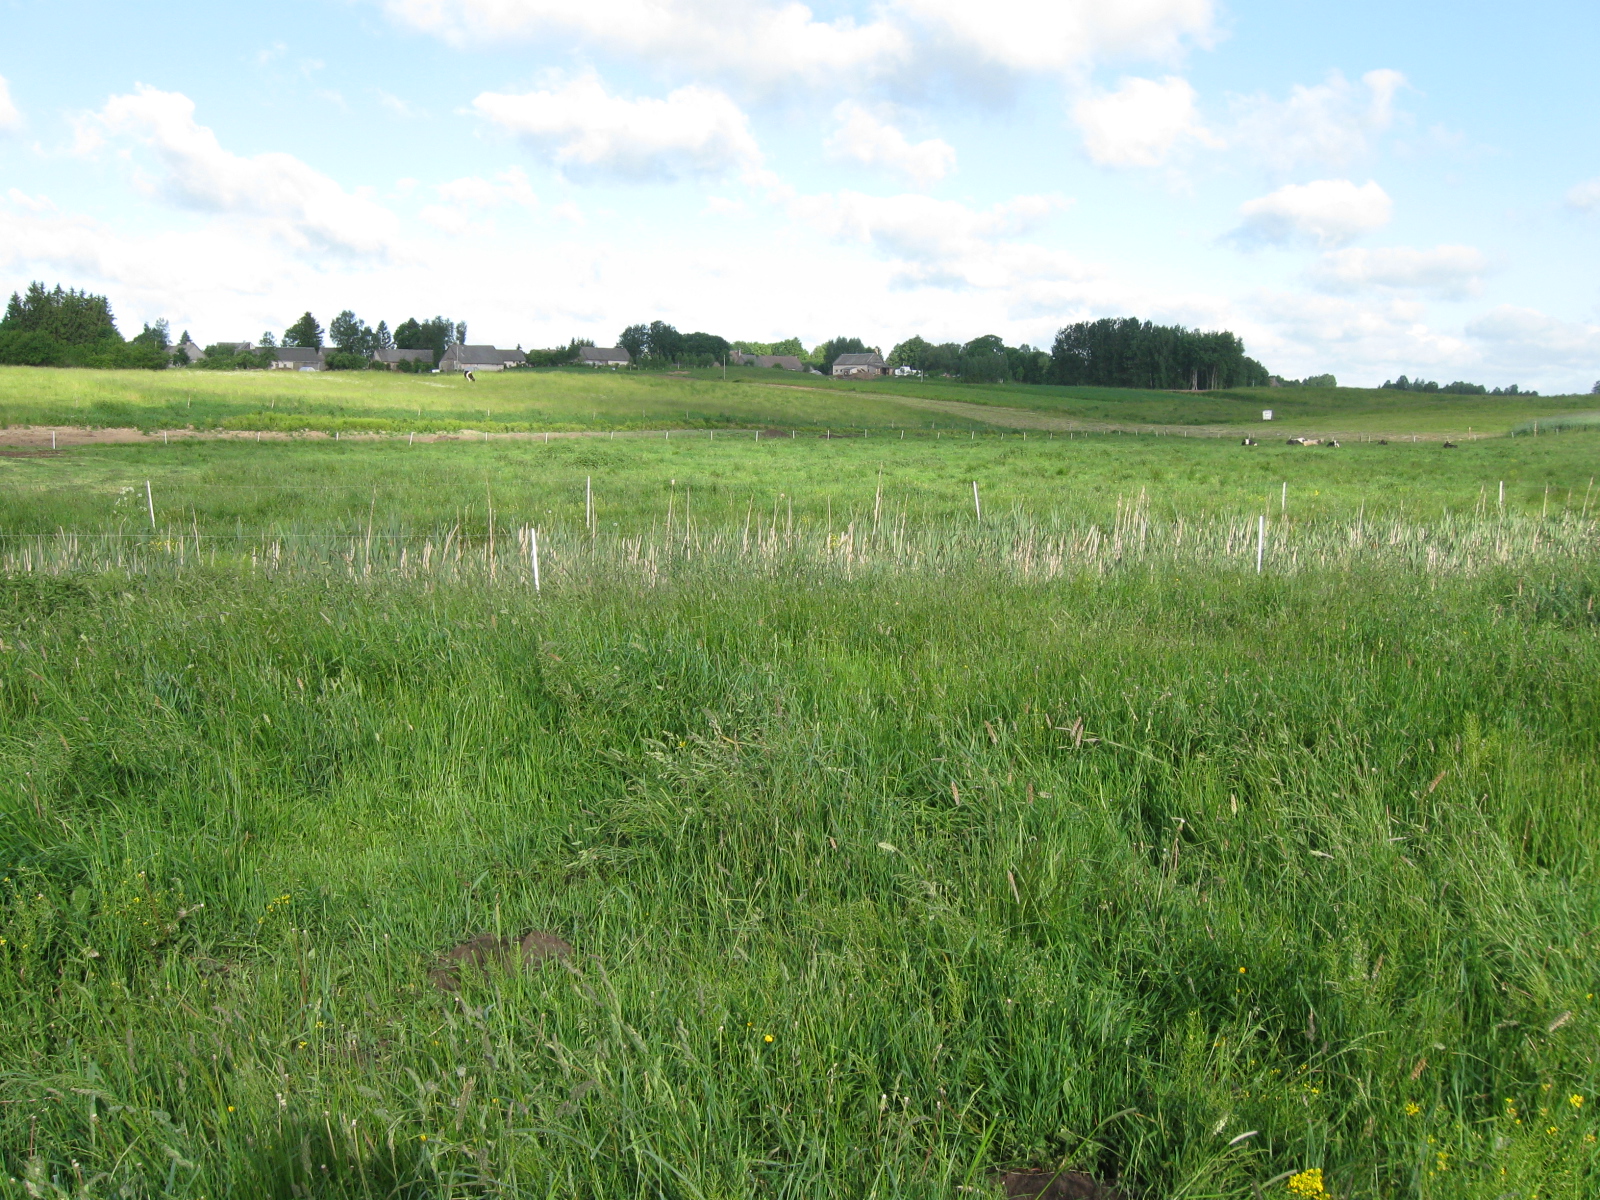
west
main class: Grassland
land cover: Grassland without tree/shrub cover
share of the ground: > 75 %
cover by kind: herbaceous plants 100 %
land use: Agriculture (excluding fallow land and kitchen gardens)
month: June
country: LT
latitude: 54.3668
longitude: 23.8962
